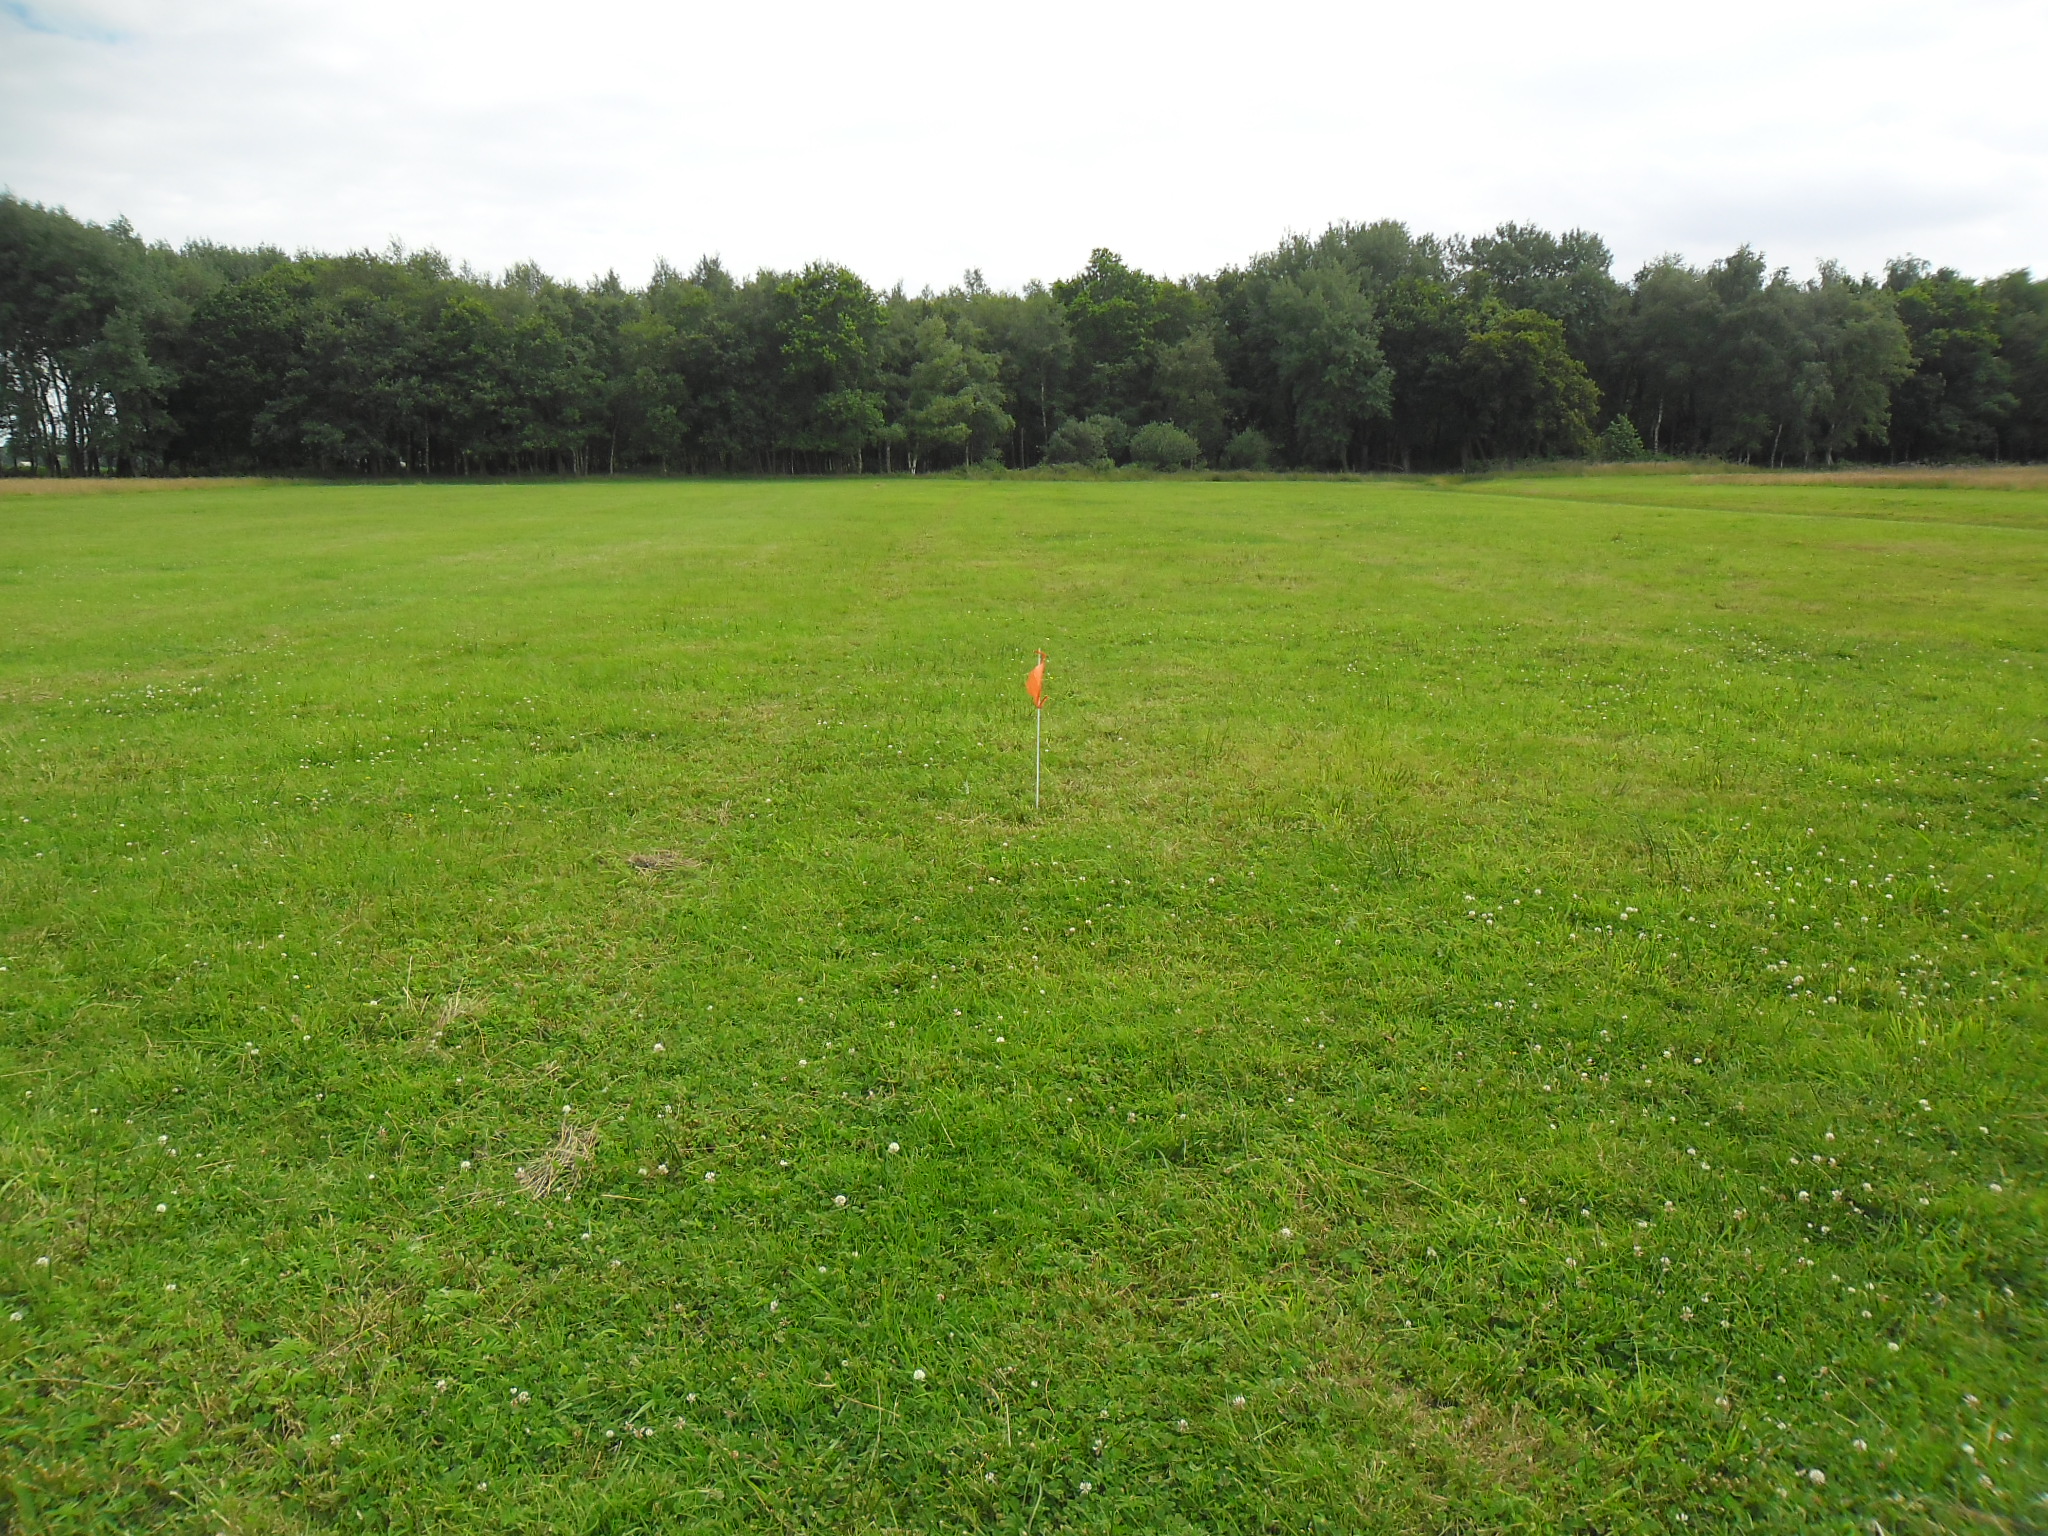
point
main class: Grassland
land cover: Grassland without tree/shrub cover
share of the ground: > 75 %
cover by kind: herbaceous plants 100 %
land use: Agriculture (excluding fallow land and kitchen gardens)
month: July
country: NL
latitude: 53.0154
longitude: 6.7059
